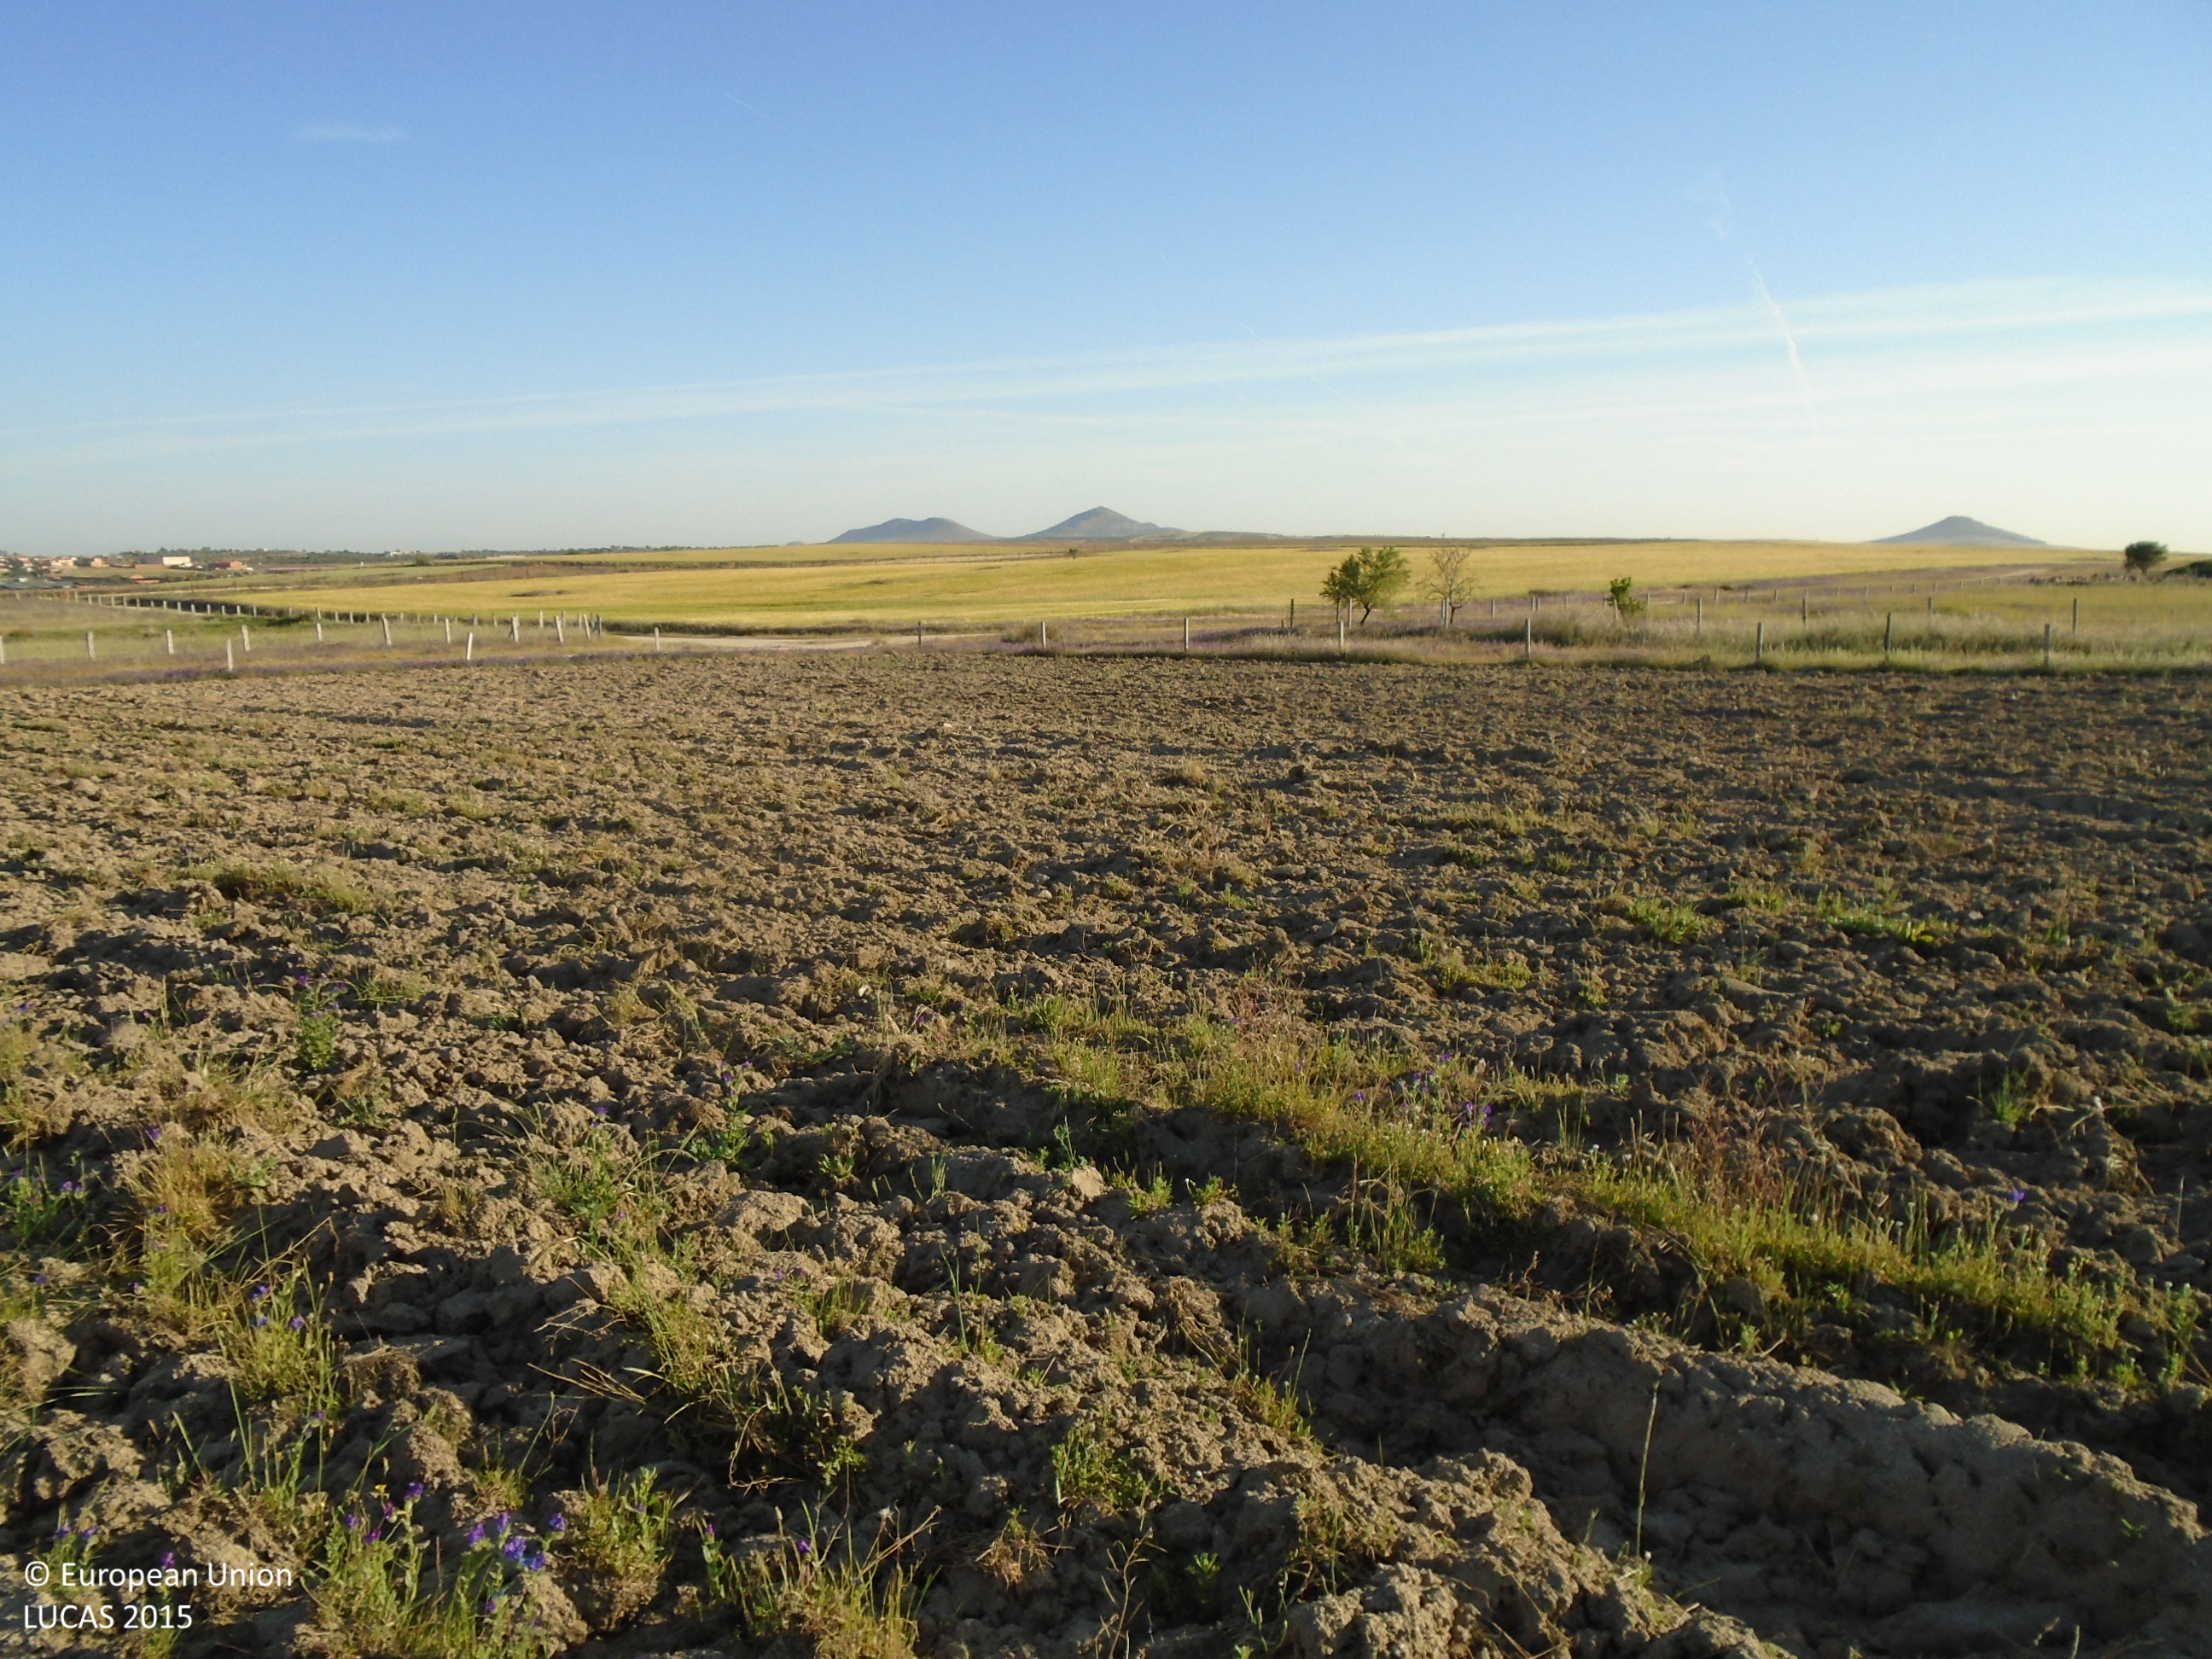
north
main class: Grassland
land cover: Spontaneously vegetated surfaces
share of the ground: > 75 %
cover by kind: herbaceous plants 100 %
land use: Agriculture (excluding fallow land and kitchen gardens)
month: May
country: ES
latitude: 39.6514
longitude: -4.1937
